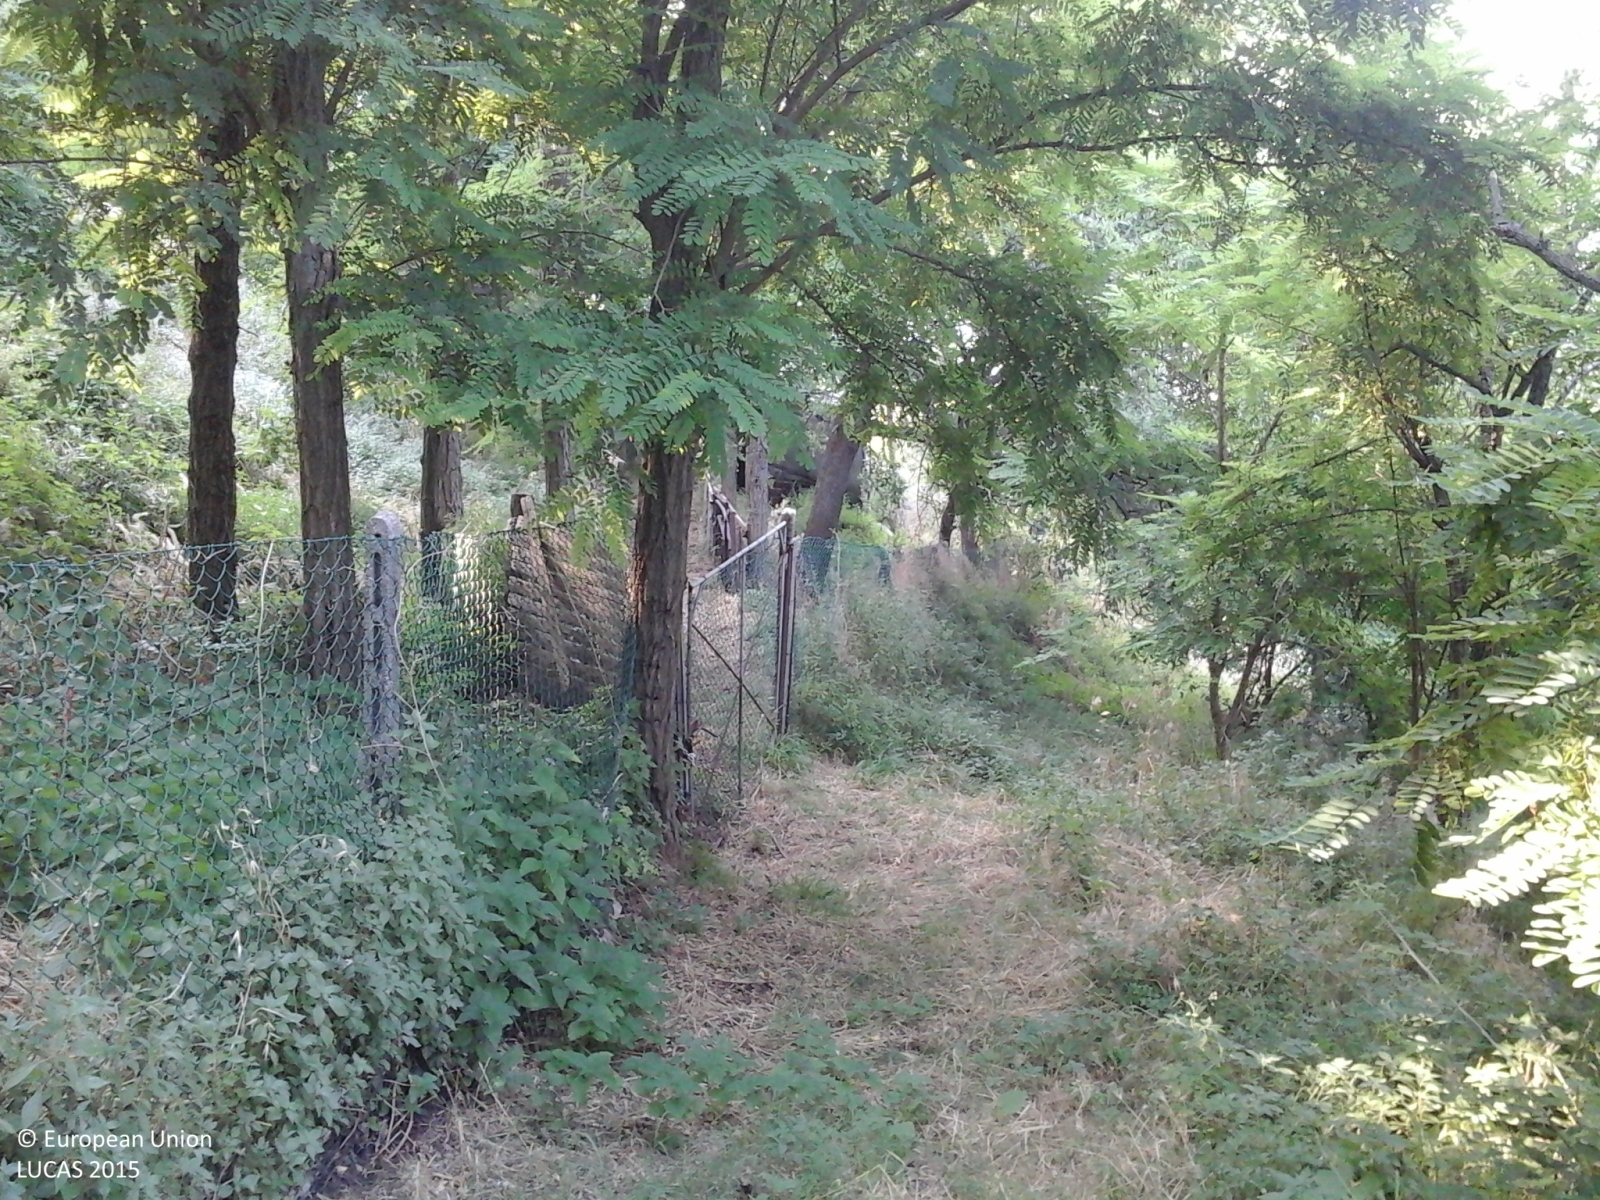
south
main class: Woodland
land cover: Broadleaved woodland
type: thermophilous deciduous forest
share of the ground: > 75 %
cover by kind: broadleaved forest trees 100 %
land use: Semi-natural and natural areas not in use
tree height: > 5 m
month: July
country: IT
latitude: 43.9991
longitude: 12.3514
